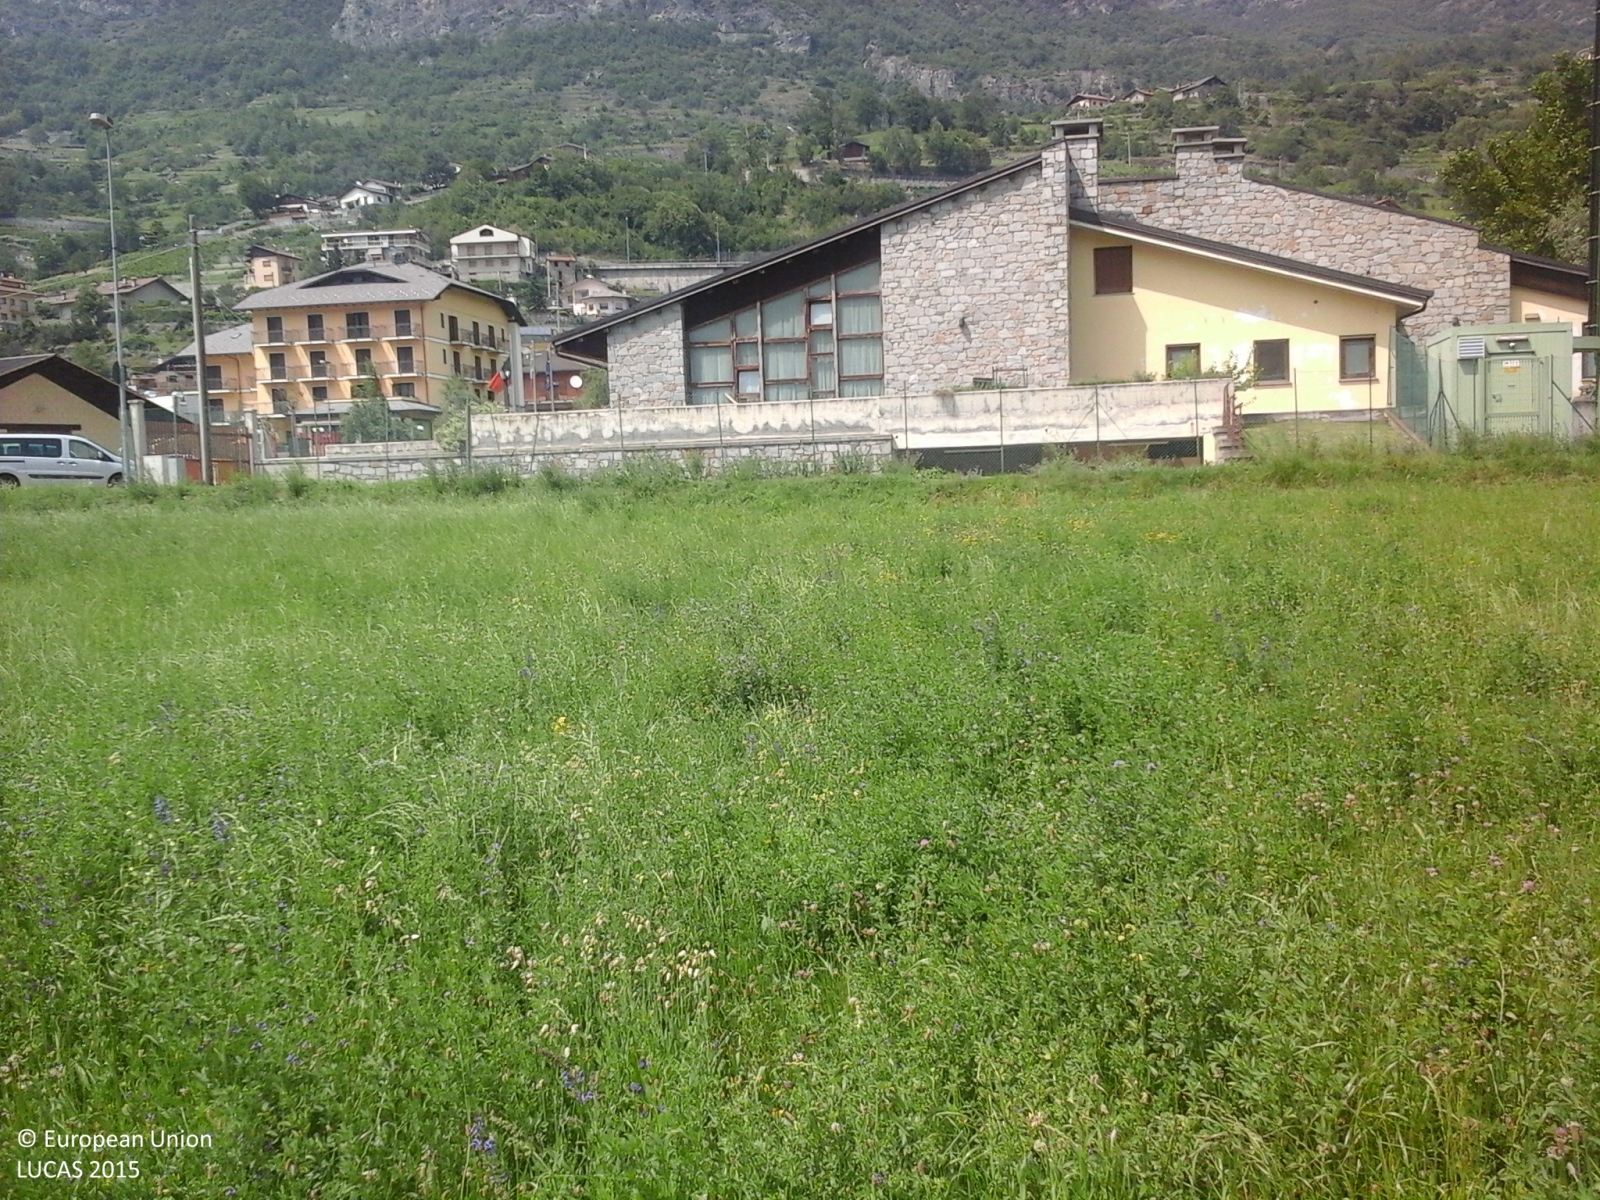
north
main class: Grassland
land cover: Grassland without tree/shrub cover
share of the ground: > 75 %
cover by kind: herbaceous plants 100 %
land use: Agriculture (excluding fallow land and kitchen gardens)
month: June
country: IT
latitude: 45.7481
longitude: 7.6253
